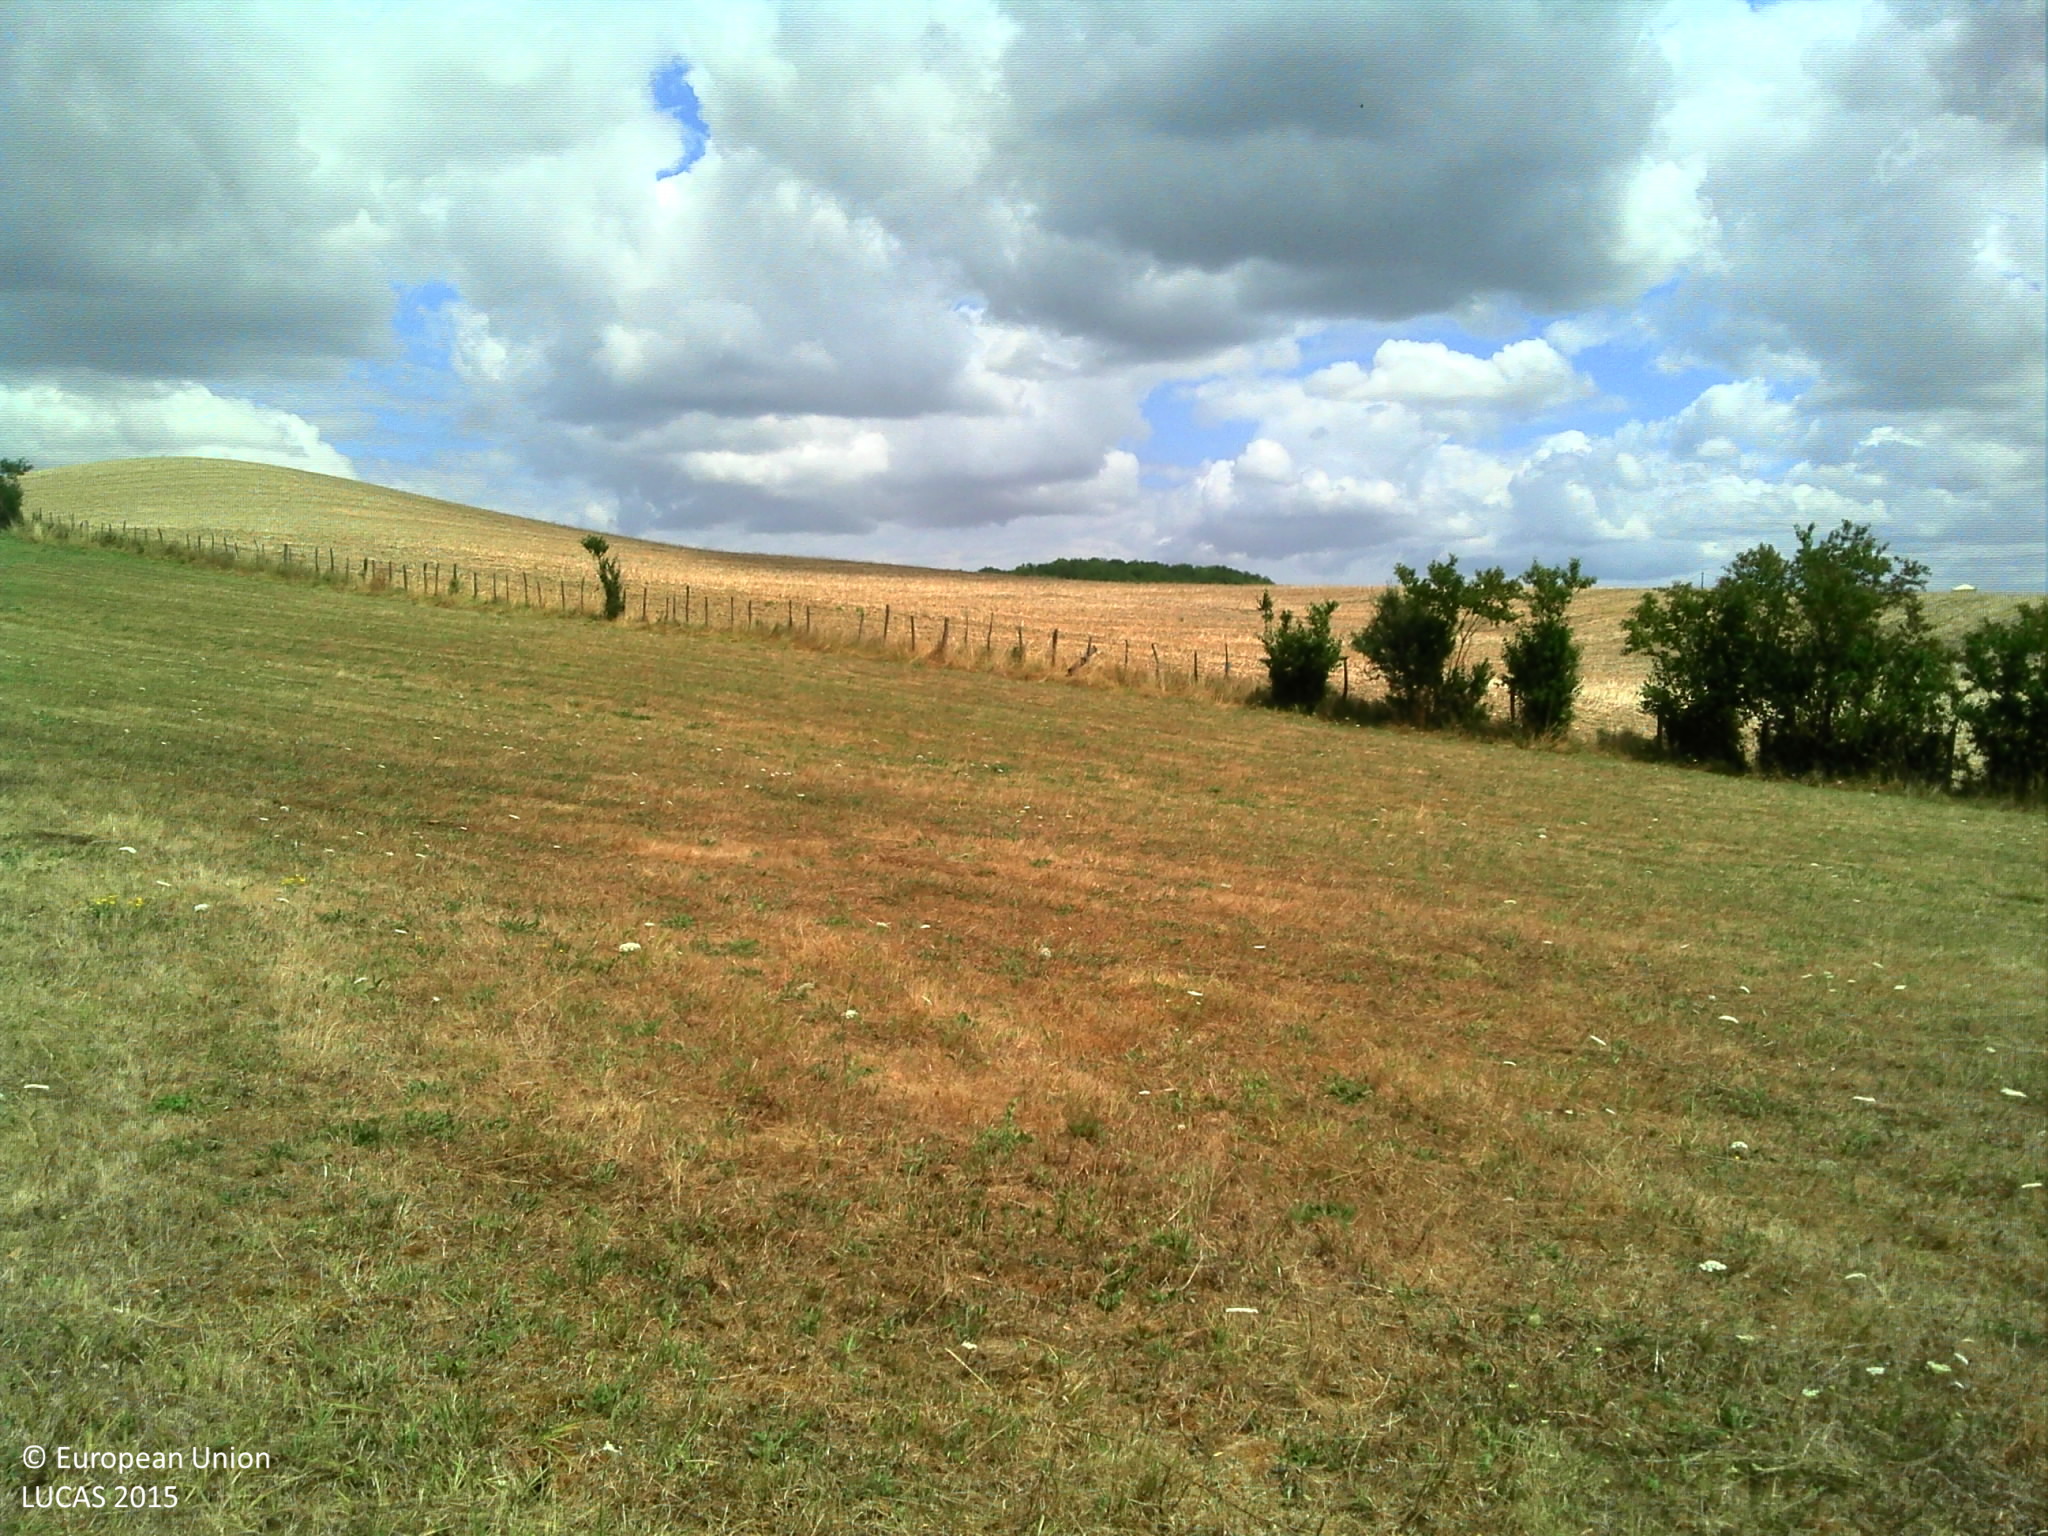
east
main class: Grassland
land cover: Grassland without tree/shrub cover
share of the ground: > 75 %
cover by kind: herbaceous plants 100 %
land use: Agriculture (excluding fallow land and kitchen gardens)
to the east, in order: Grassland without tree/shrub cover; Fences; Rape and turnip rape
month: July
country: FR
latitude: 44.4833
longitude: 0.5753
